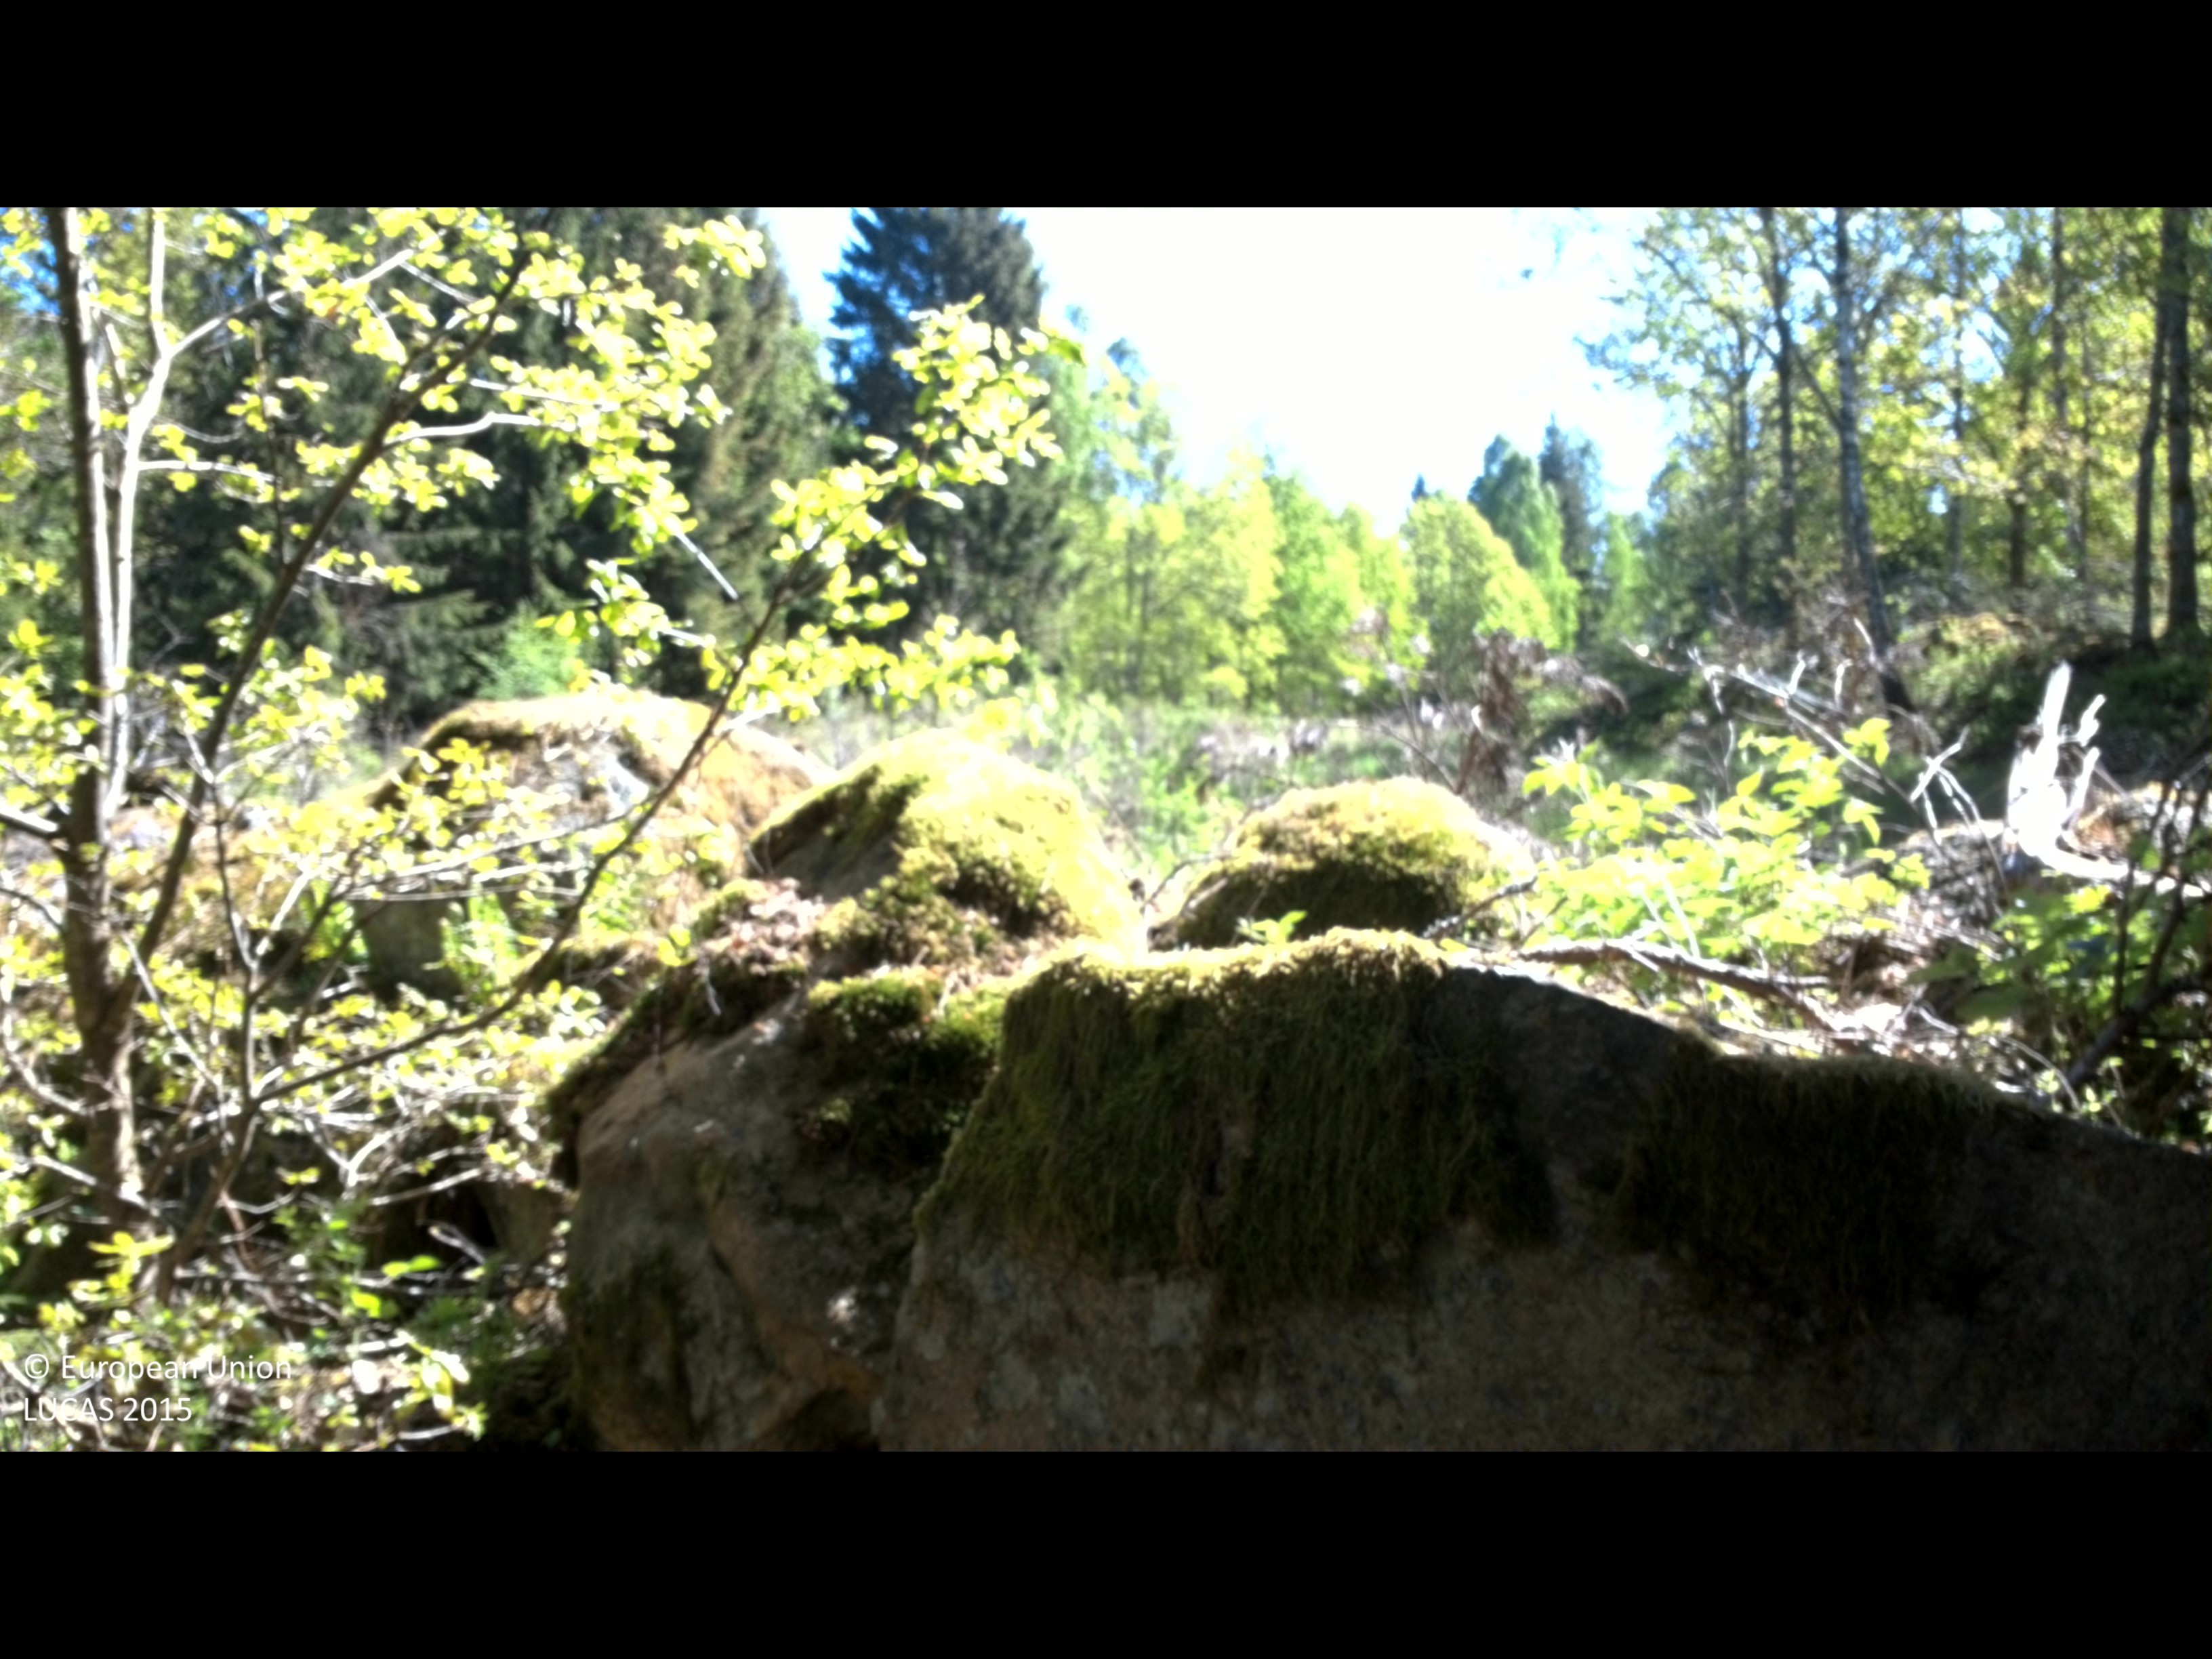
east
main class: Woodland
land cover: Spruce dominated mixed woodland
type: boreal forest
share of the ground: > 75 %
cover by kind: coniferous forest trees 65 %, broadleaved forest trees 25 %, shrubs 5 %, herbaceous plants 5 %
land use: Forestry
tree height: > 5 m
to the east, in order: Spruce dominated mixed woodland; Dry stone walls; Shrubland with sparse tree cover; Broadleaved woodland; Dry stone walls; Paved roads, cycling and walking lanes; Fences; Broadleaved woodland; Fences; Pine dominated coniferous woodland
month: May
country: SE
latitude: 57.2832
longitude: 16.1865
